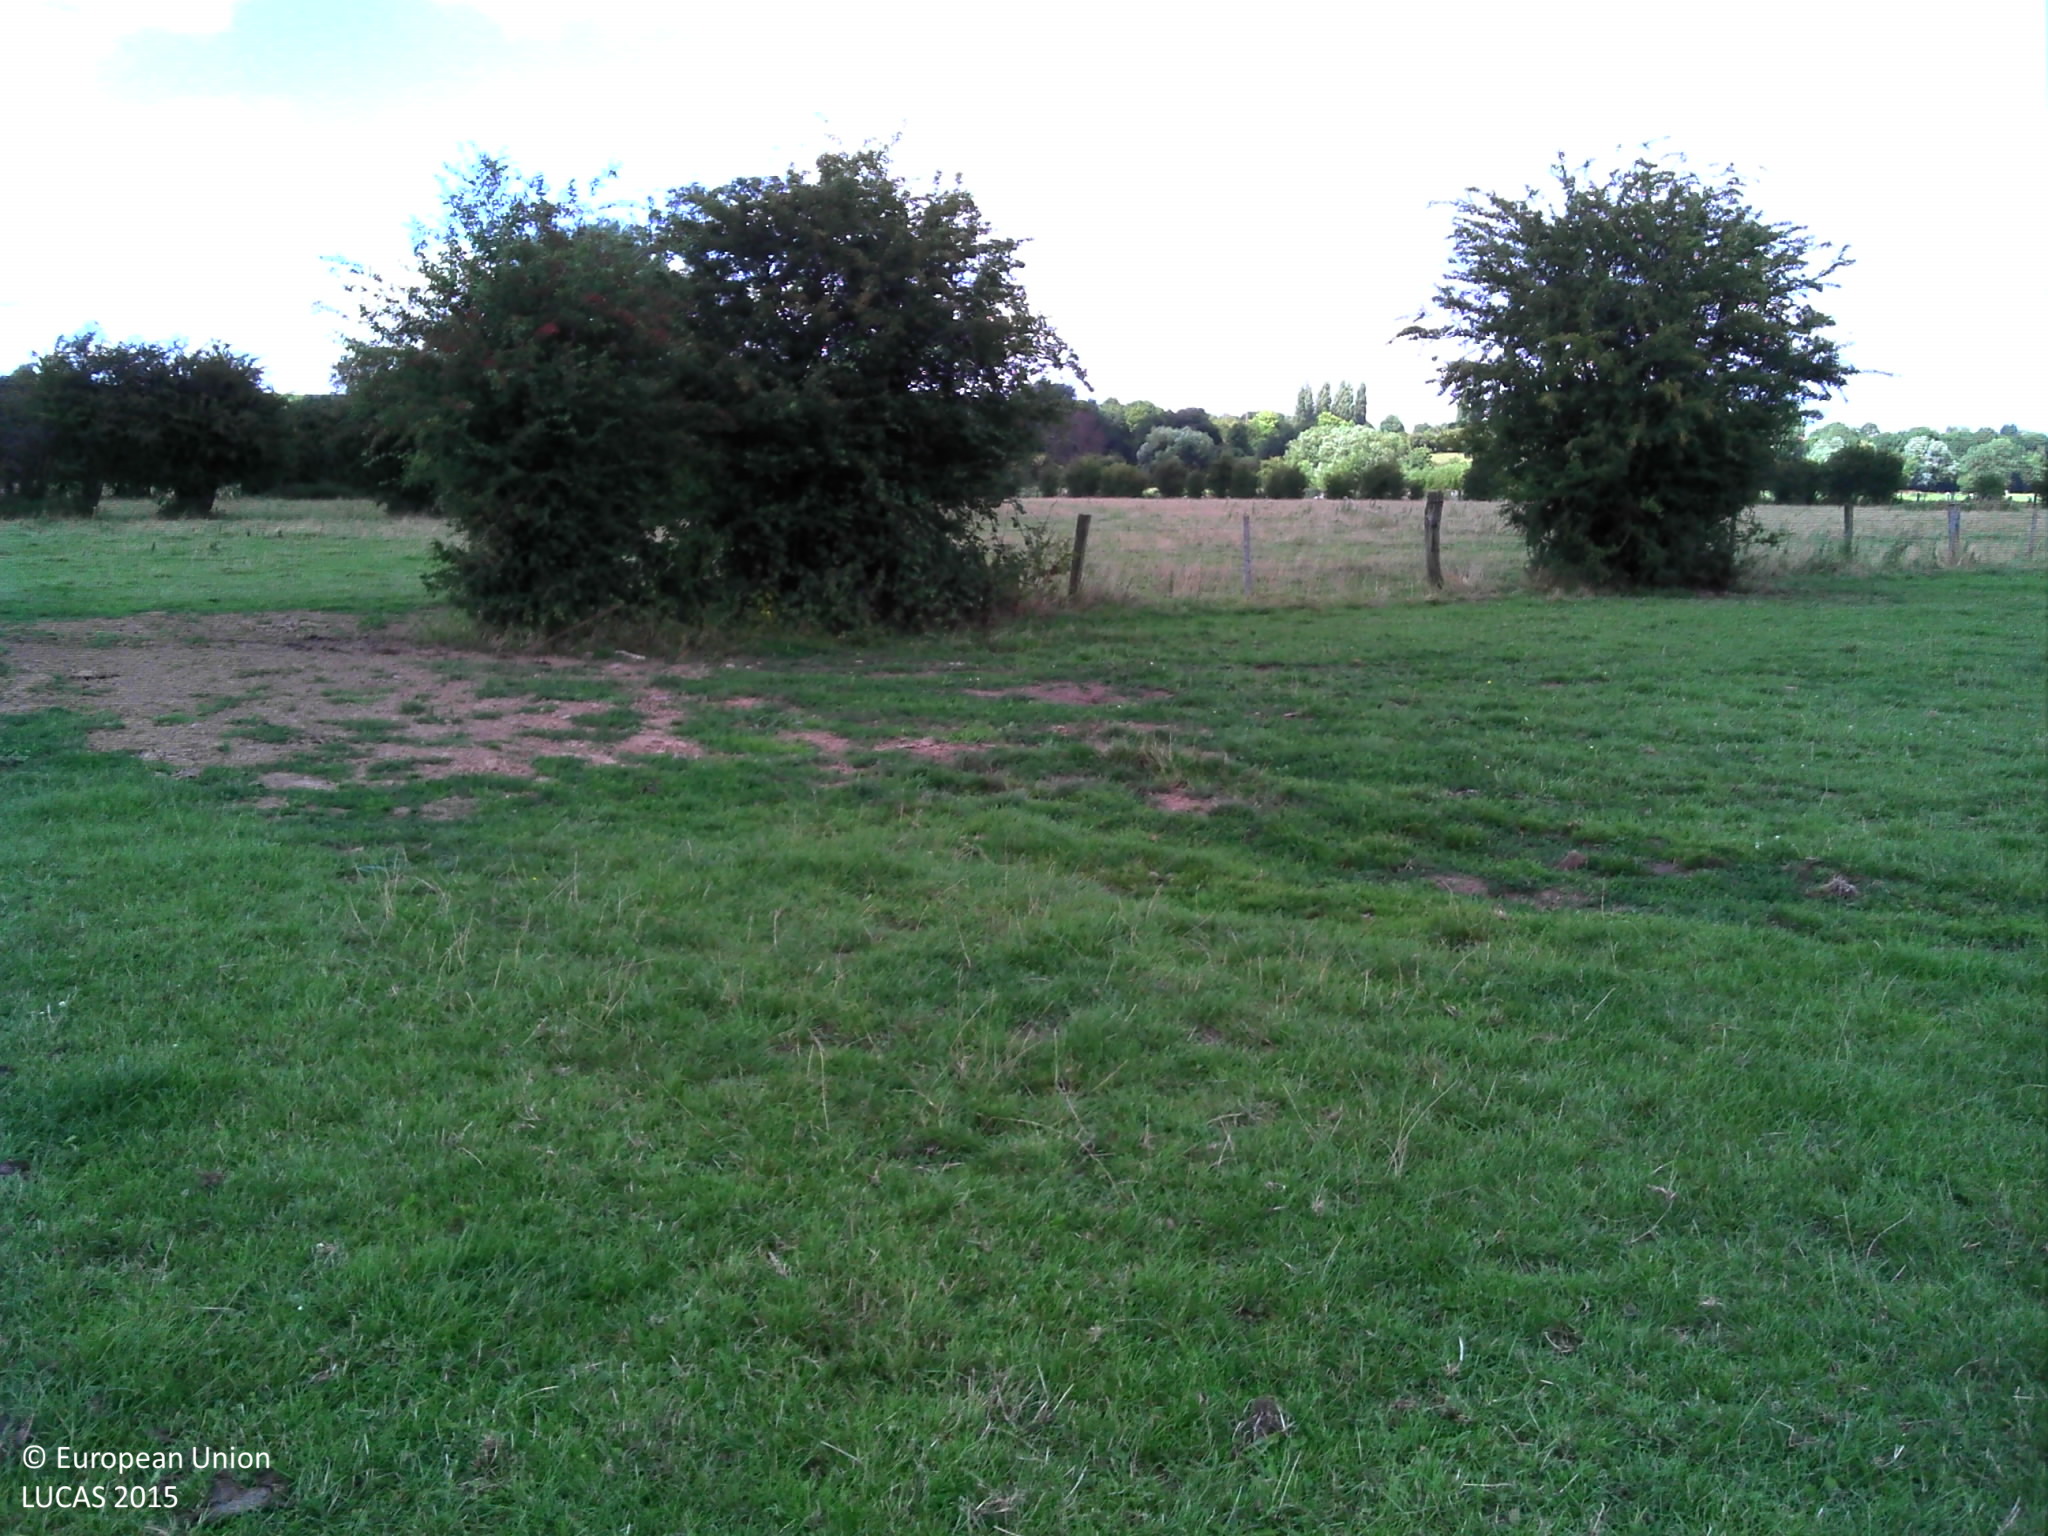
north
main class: Grassland
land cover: Grassland without tree/shrub cover
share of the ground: > 75 %
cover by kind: herbaceous plants 100 %
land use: Agriculture (excluding fallow land and kitchen gardens)
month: August
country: FR
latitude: 50.2788
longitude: 4.0023
